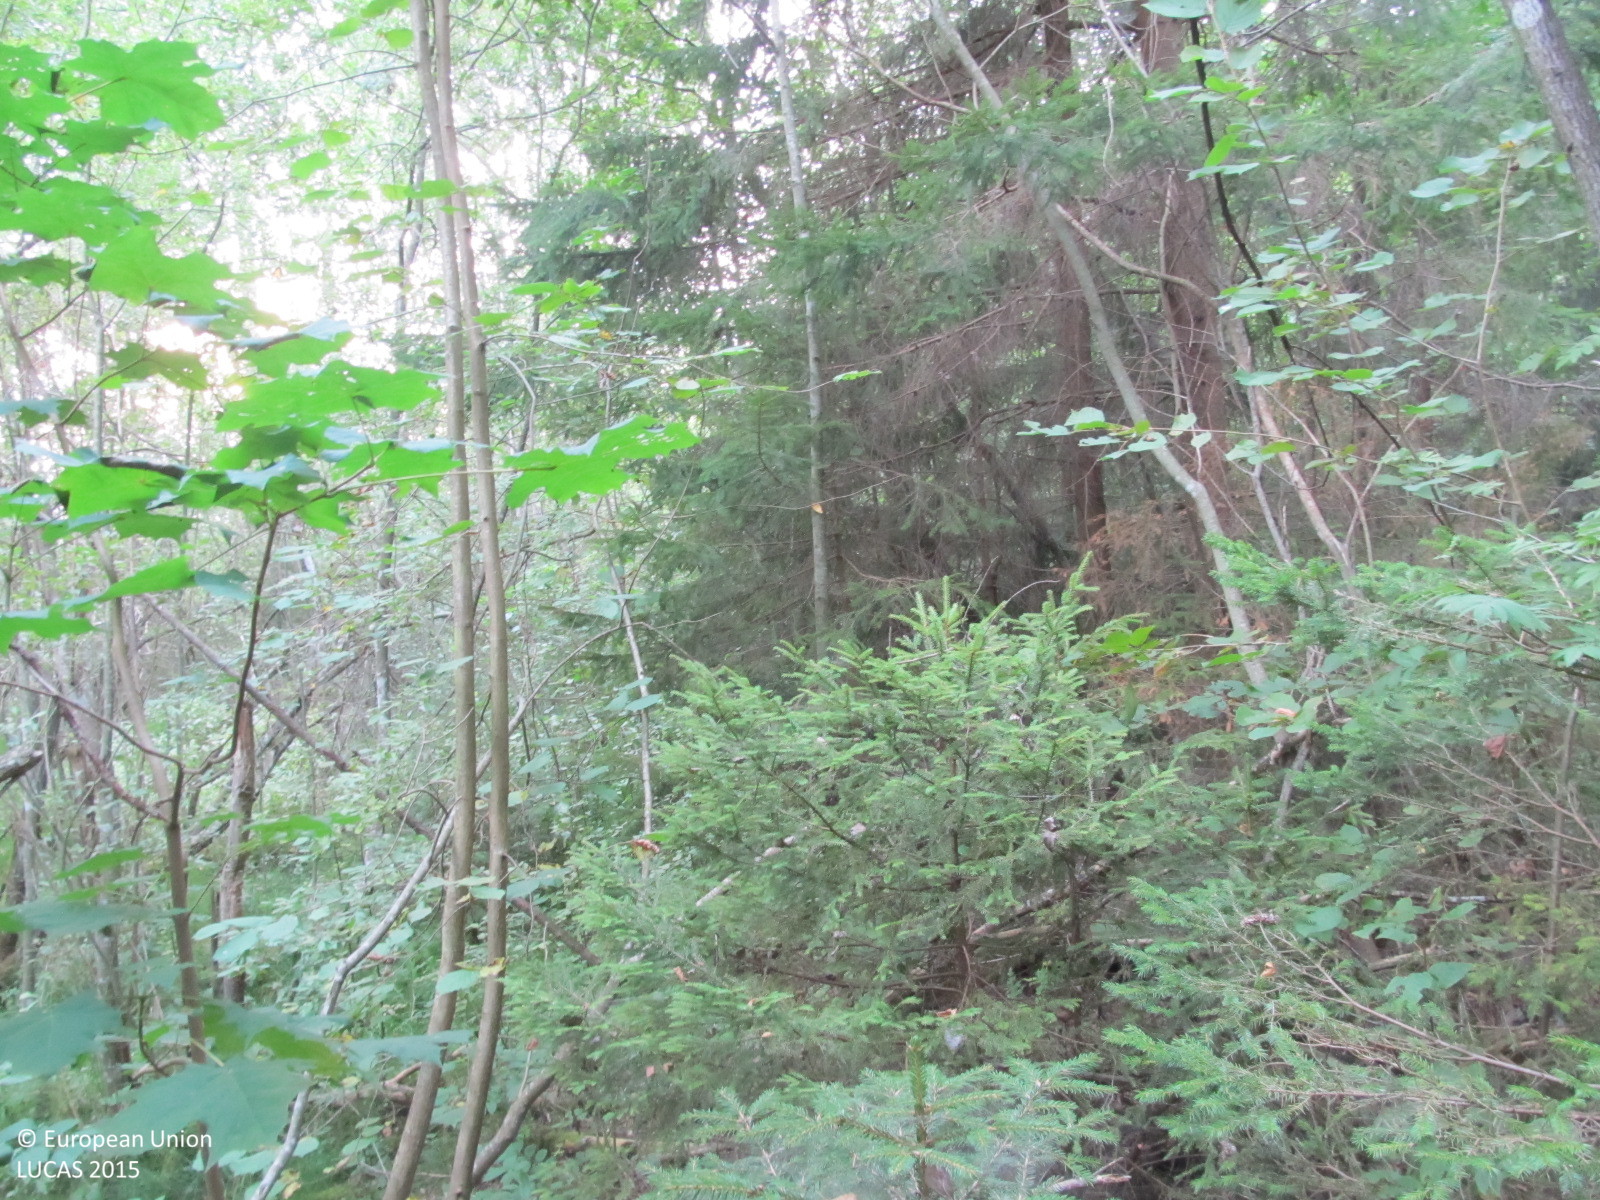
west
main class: Woodland
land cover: Other mixed woodland
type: hemiboreal forest and nemoral coniferous forest and mixed broadleaved-coniferous forest
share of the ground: > 75 %
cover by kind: coniferous forest trees 50 %, broadleaved forest trees 30 %, herbaceous plants 15 %, shrubs 5 %
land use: Forestry
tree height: > 5 m
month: August
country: LT
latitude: 55.8566
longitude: 23.1226
